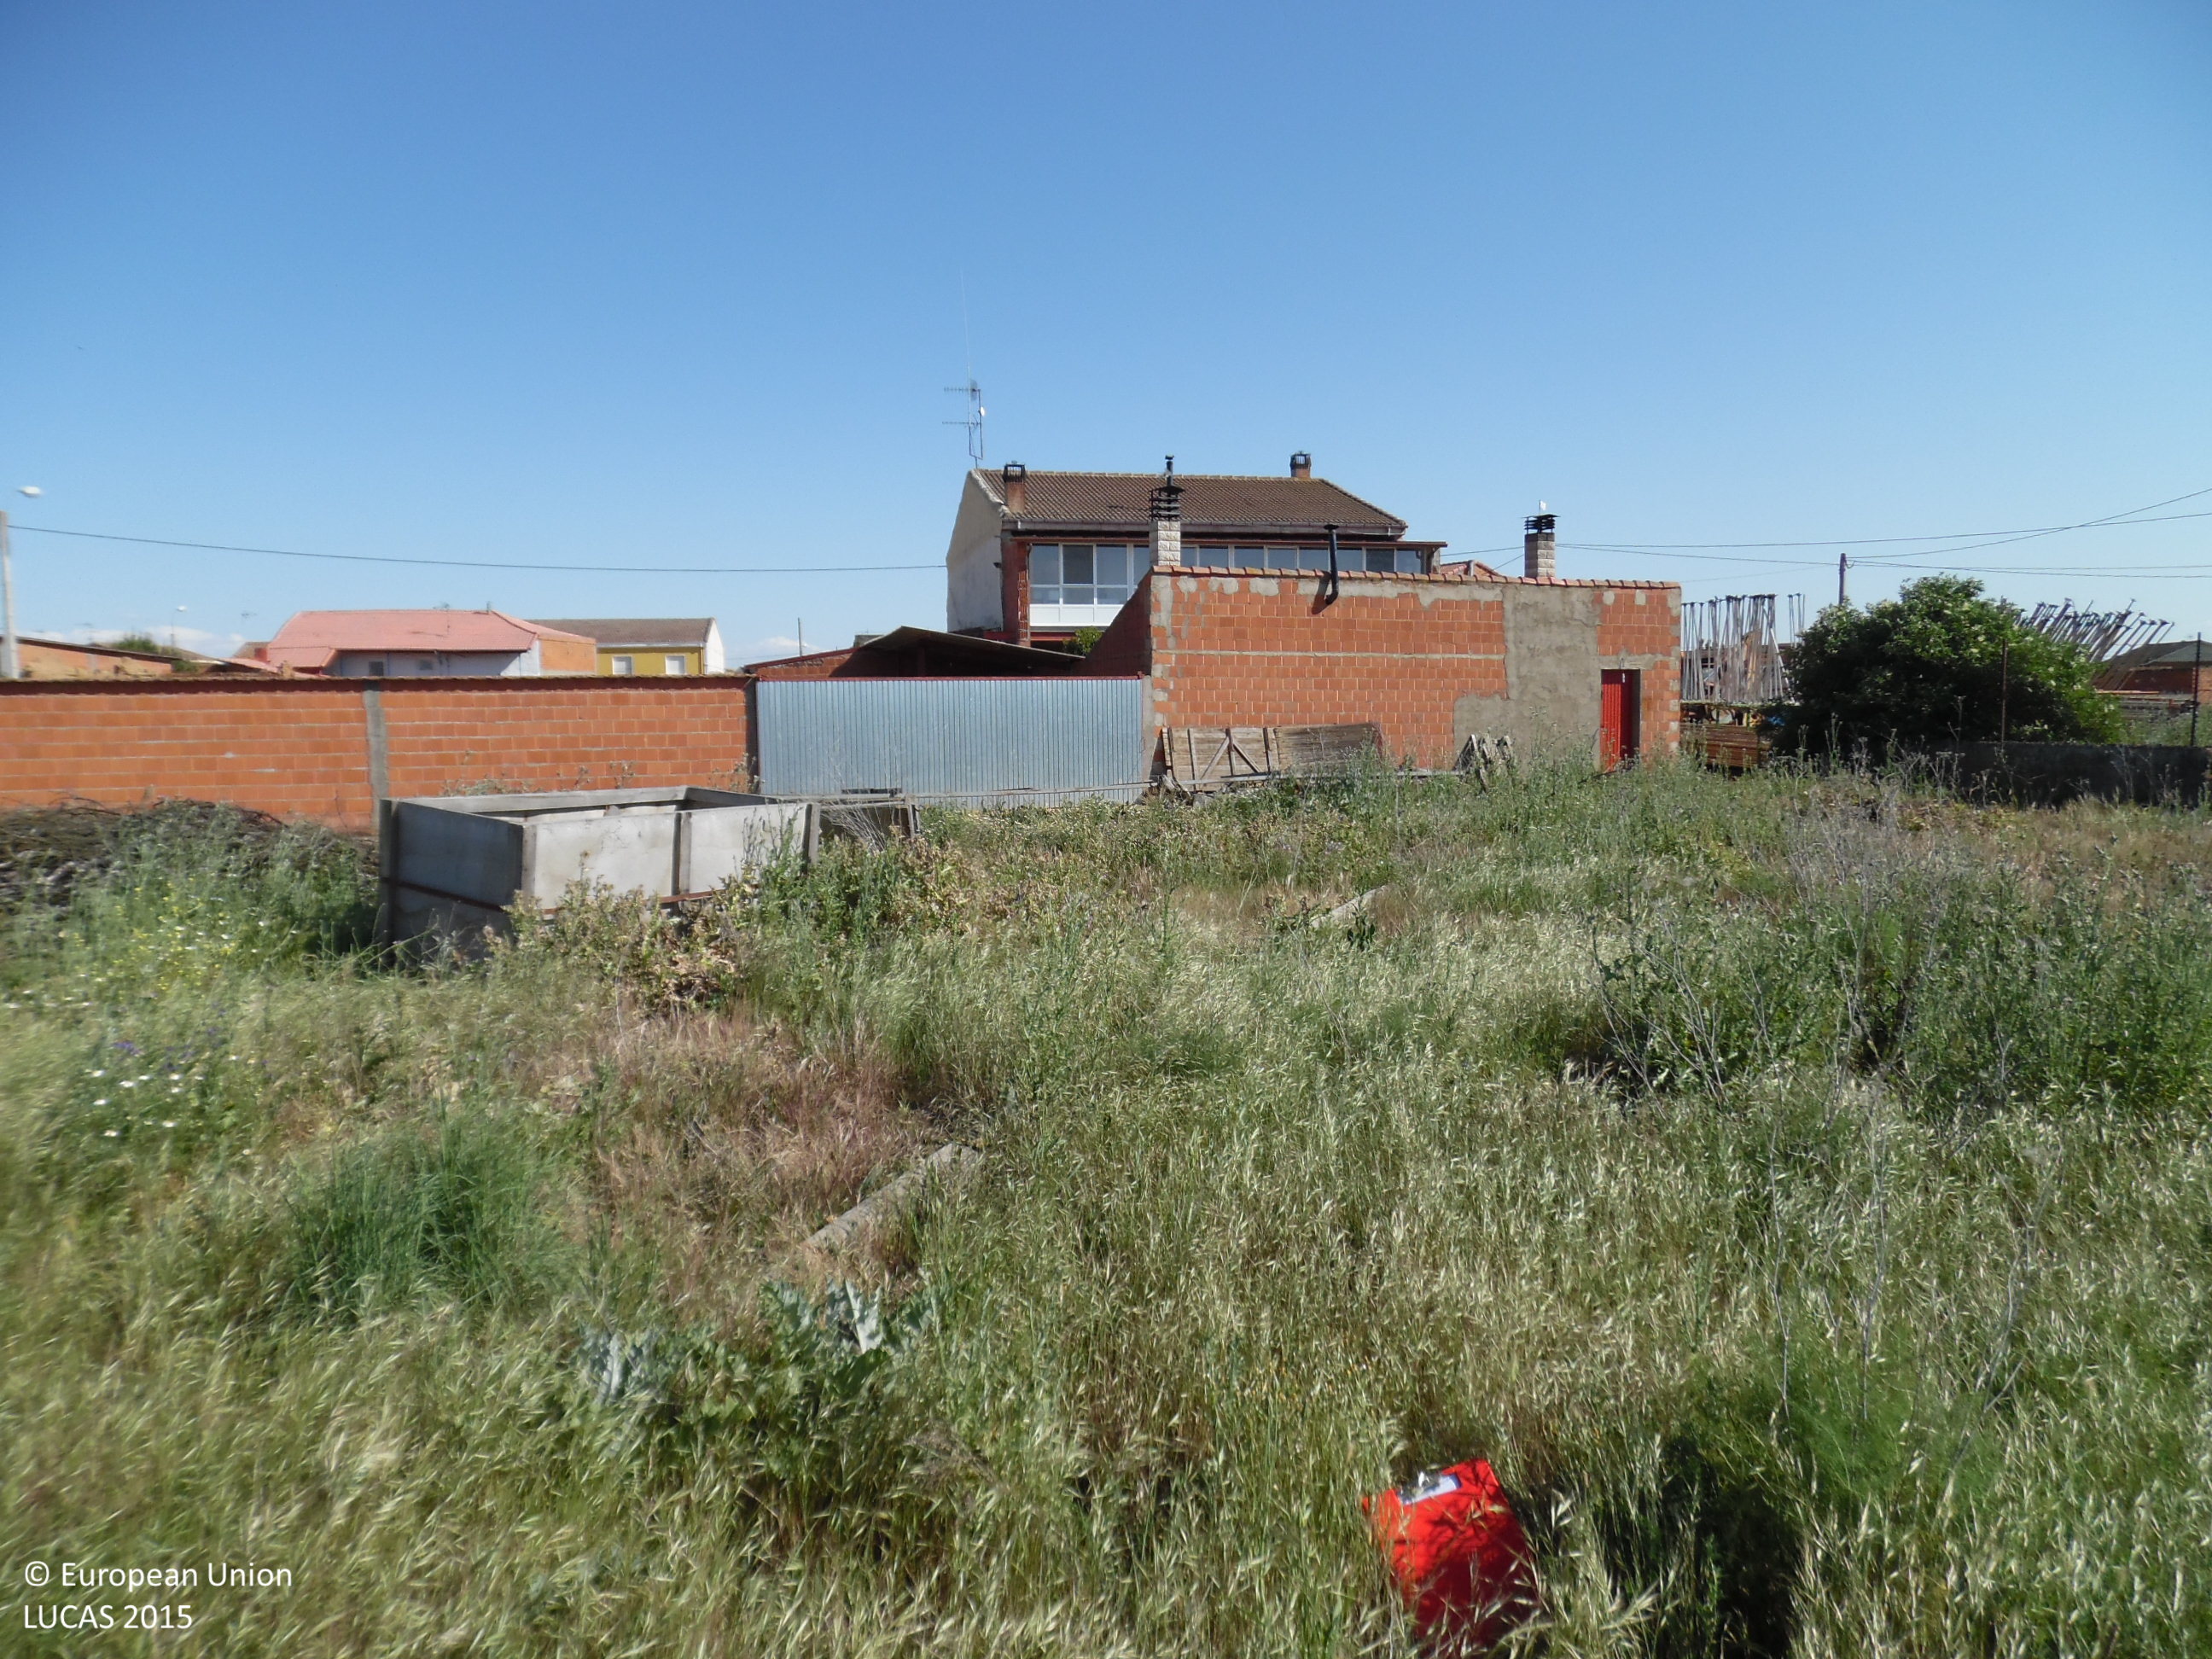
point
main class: Grassland
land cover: Grassland without tree/shrub cover
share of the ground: > 75 %
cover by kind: herbaceous plants 95 %, shrubs 5 %
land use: Abandoned areas
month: May
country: ES
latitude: 42.2443
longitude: -5.7175
